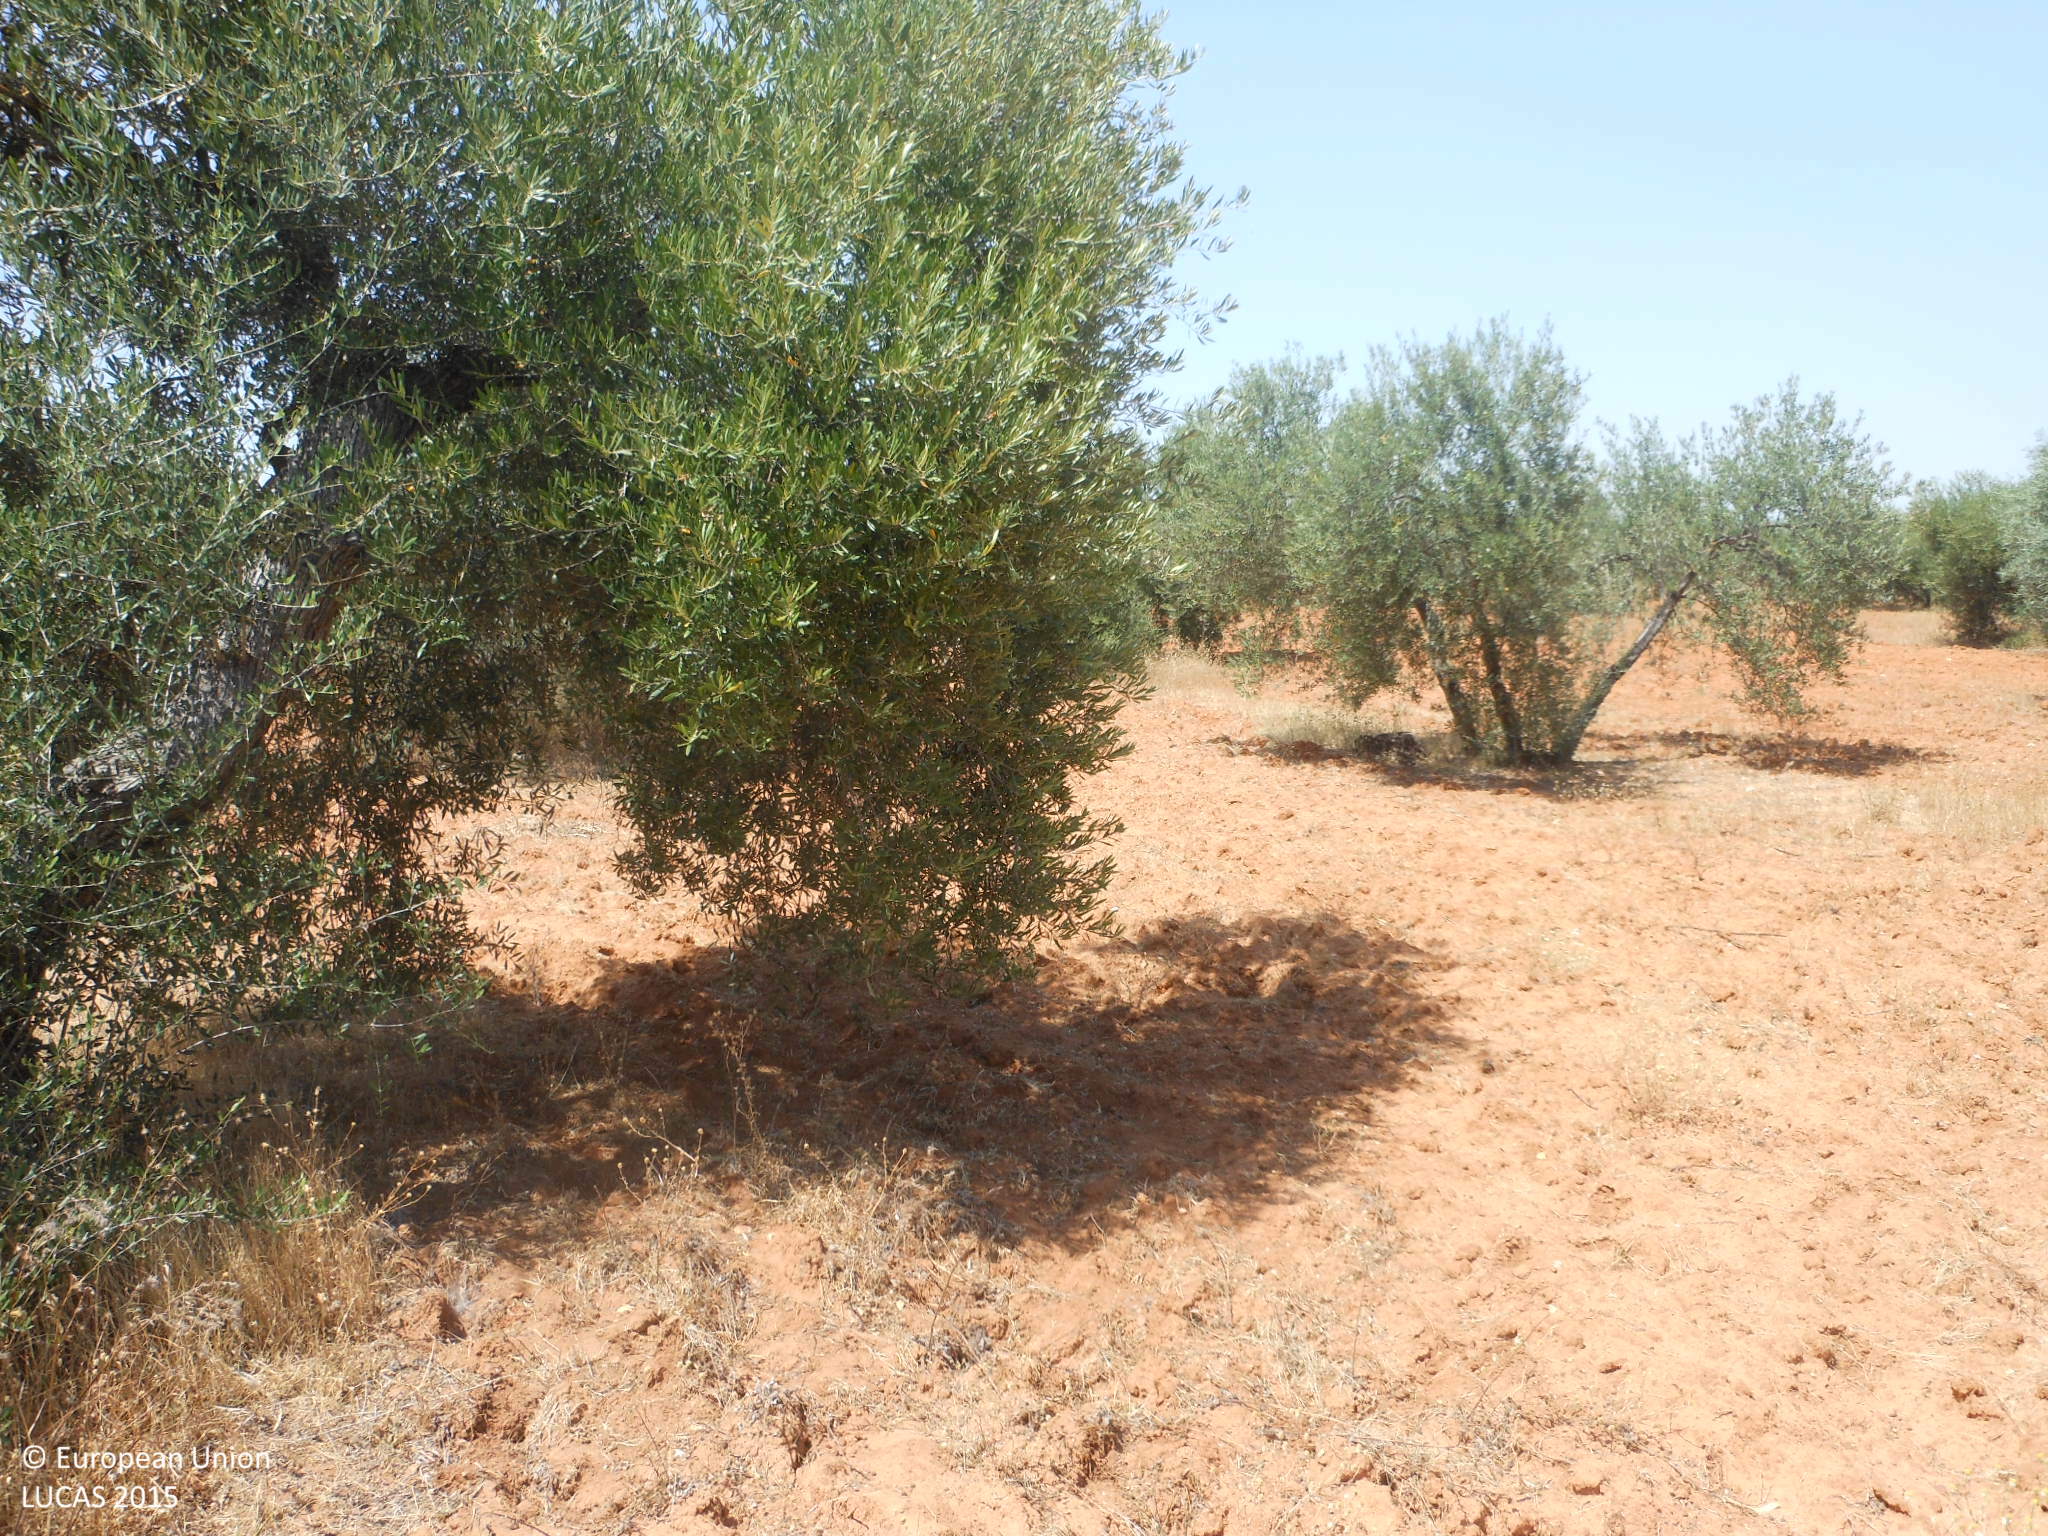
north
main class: Cropland
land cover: Olive groves
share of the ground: 25 - 50 %
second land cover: Other bare soil
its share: > 75 %
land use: Agriculture (excluding fallow land and kitchen gardens)
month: June
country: ES
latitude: 37.2153
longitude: -5.4389
